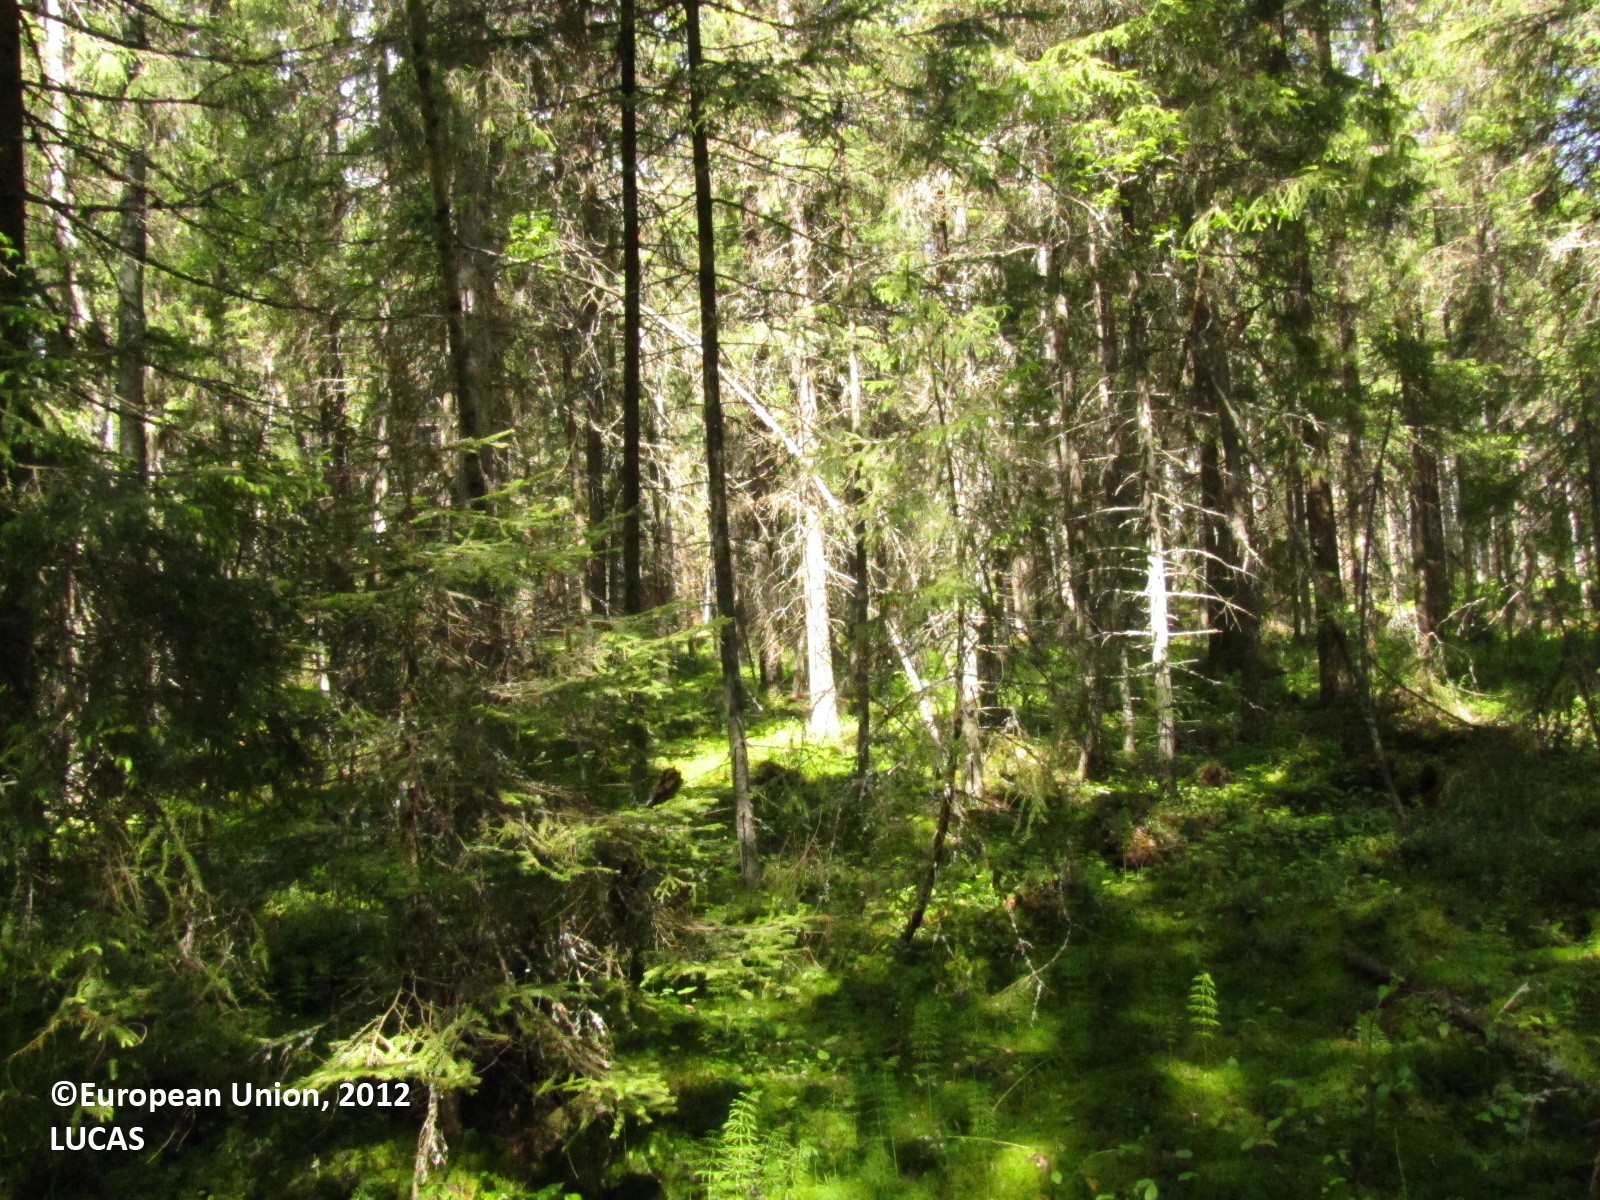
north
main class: Woodland
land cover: Spruce dominated coniferous woodland
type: boreal forest
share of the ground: > 75 %
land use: Forestry
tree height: > 5 m
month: June
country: FI
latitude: 61.6474
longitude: 23.1535
